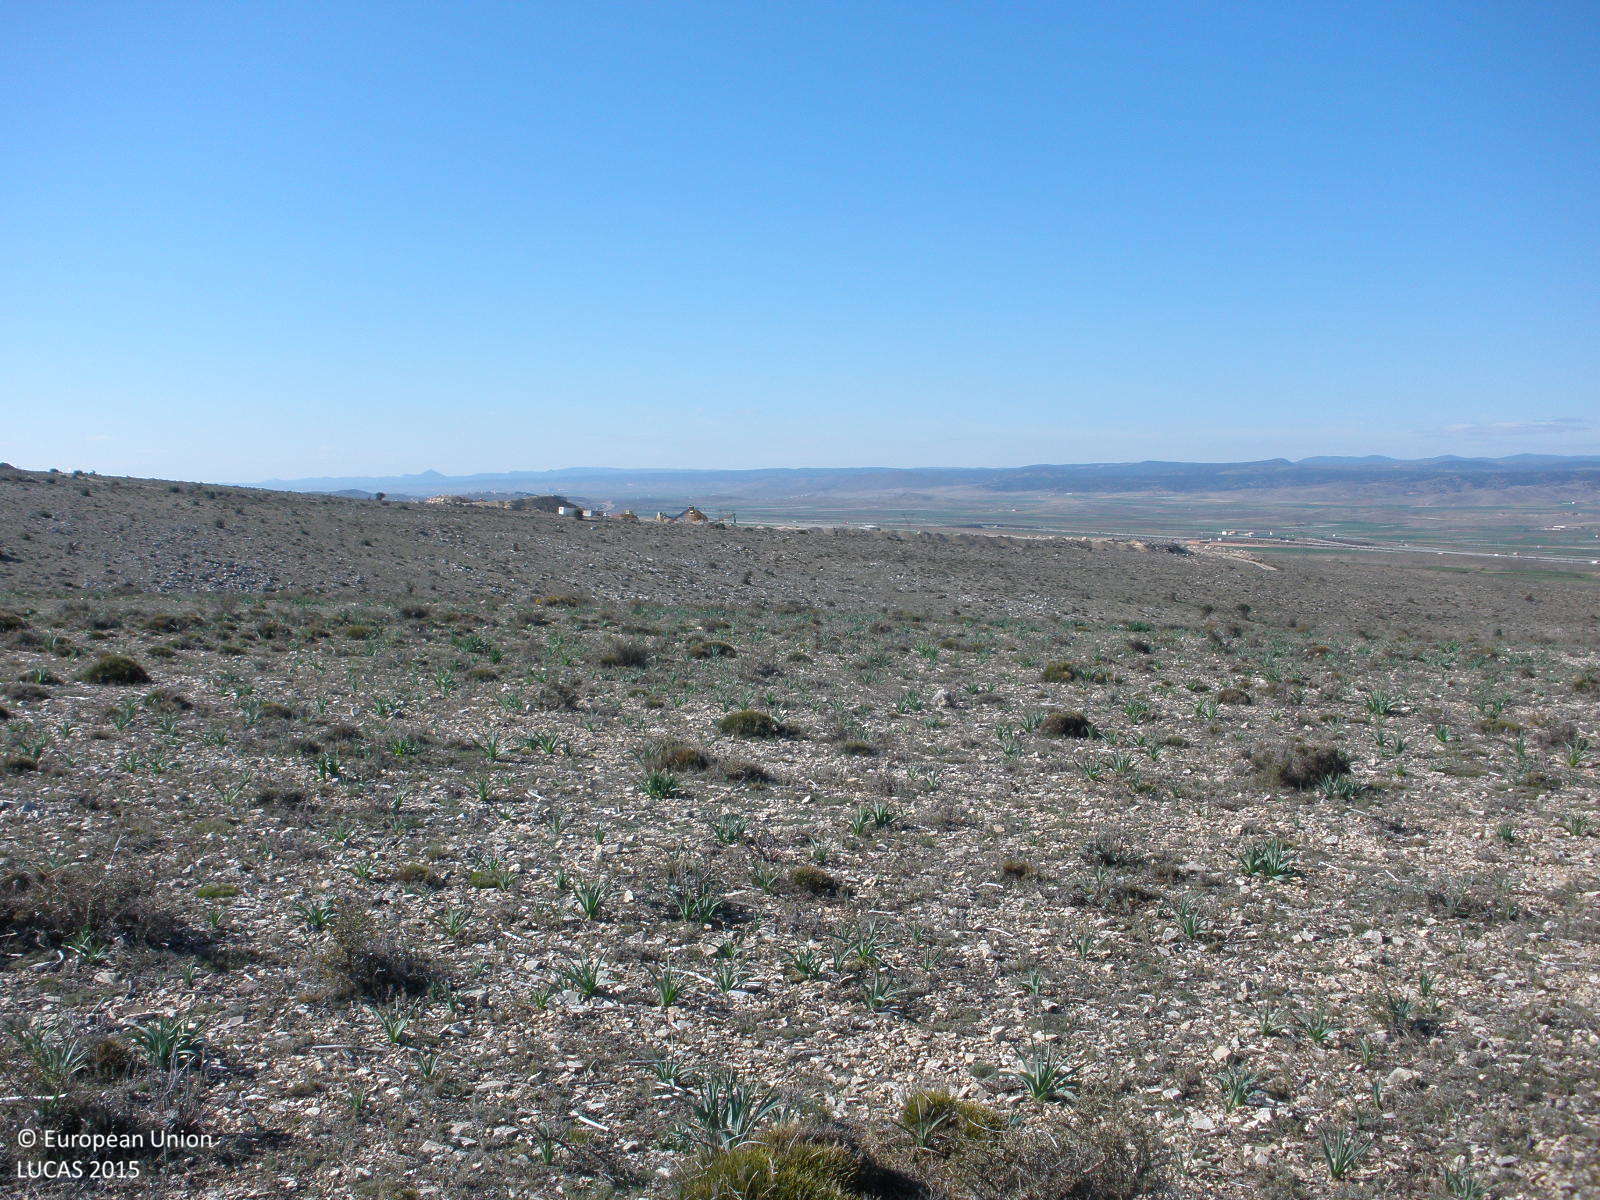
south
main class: Shrubland
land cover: Shrubland without tree cover
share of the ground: > 75 %
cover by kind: consolidated bare surface 50 %, shrubs 25 %, herbaceous plants 25 %
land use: Agriculture (excluding fallow land and kitchen gardens)
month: April
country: ES
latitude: 40.7254
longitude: -1.2990
